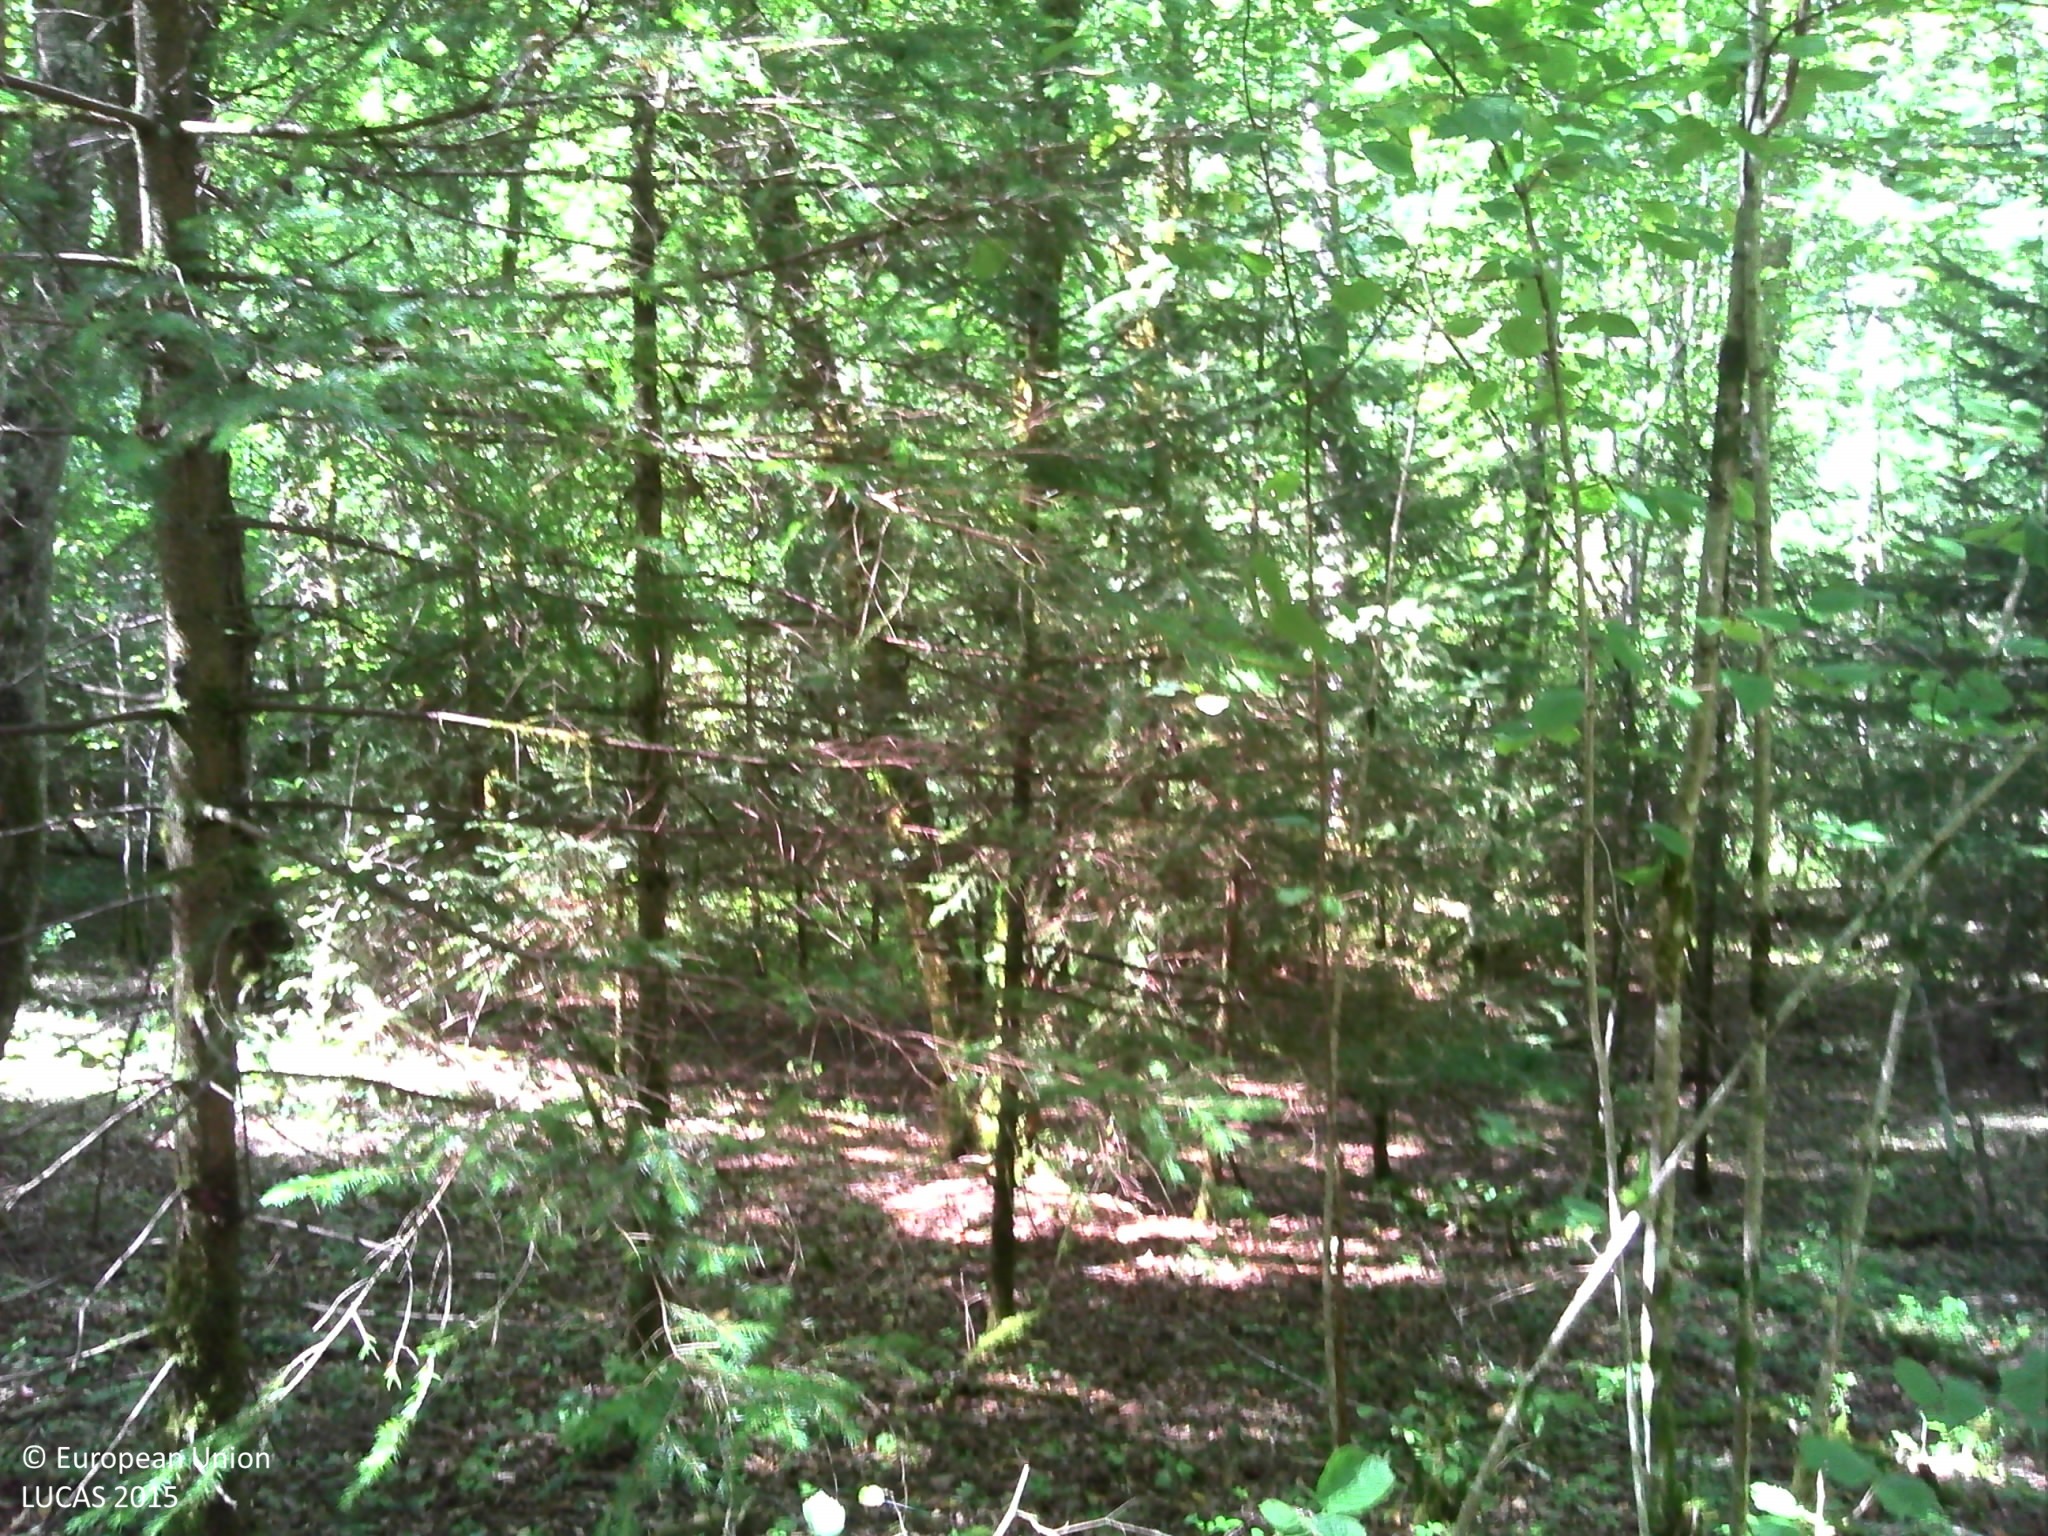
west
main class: Woodland
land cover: Broadleaved woodland
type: mesophytic deciduous forest
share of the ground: > 75 %
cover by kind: broadleaved forest trees 70 %, coniferous forest trees 20 %, herbaceous plants 5 %, lichens and mosses 5 %
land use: Forestry
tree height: > 5 m
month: August
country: FR
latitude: 47.8151
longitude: 4.8575
